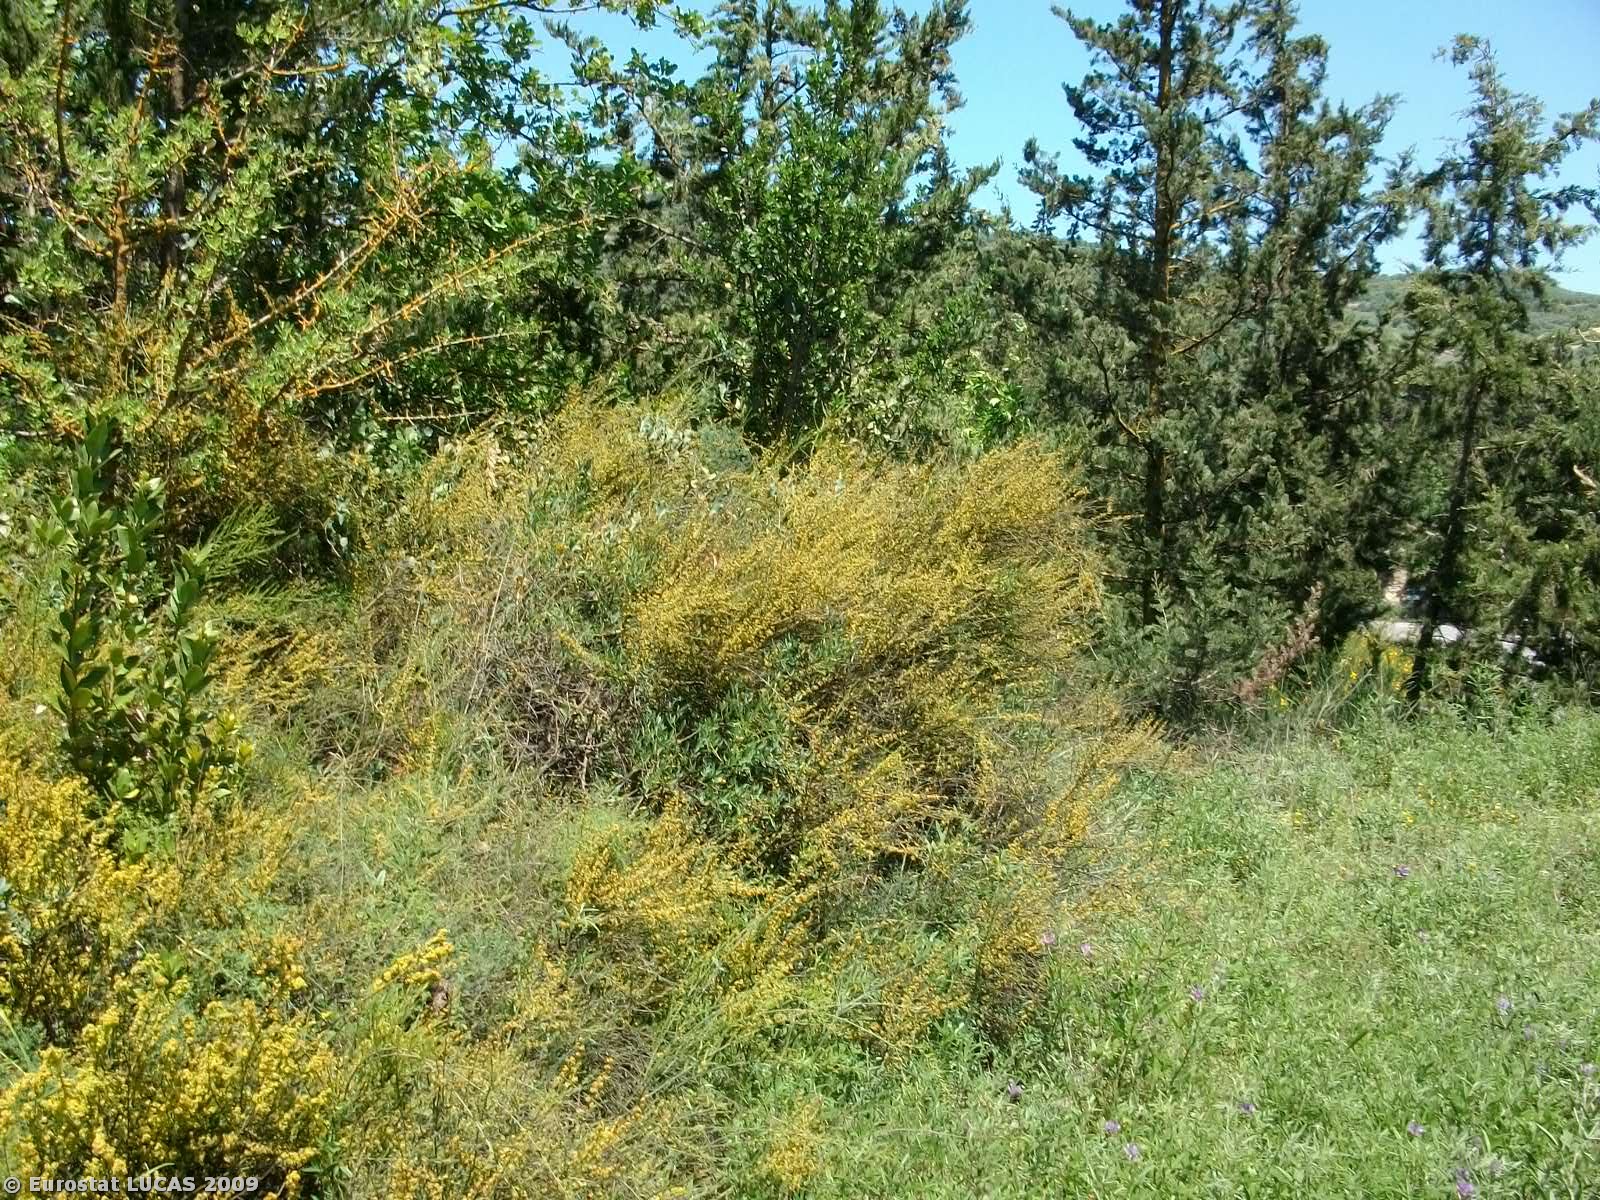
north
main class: Woodland
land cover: Mixed woodland
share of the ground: 25 - 50 %
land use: Forestry
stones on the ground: < 10 %
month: May
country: GR
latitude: 35.3673
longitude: 24.2159
